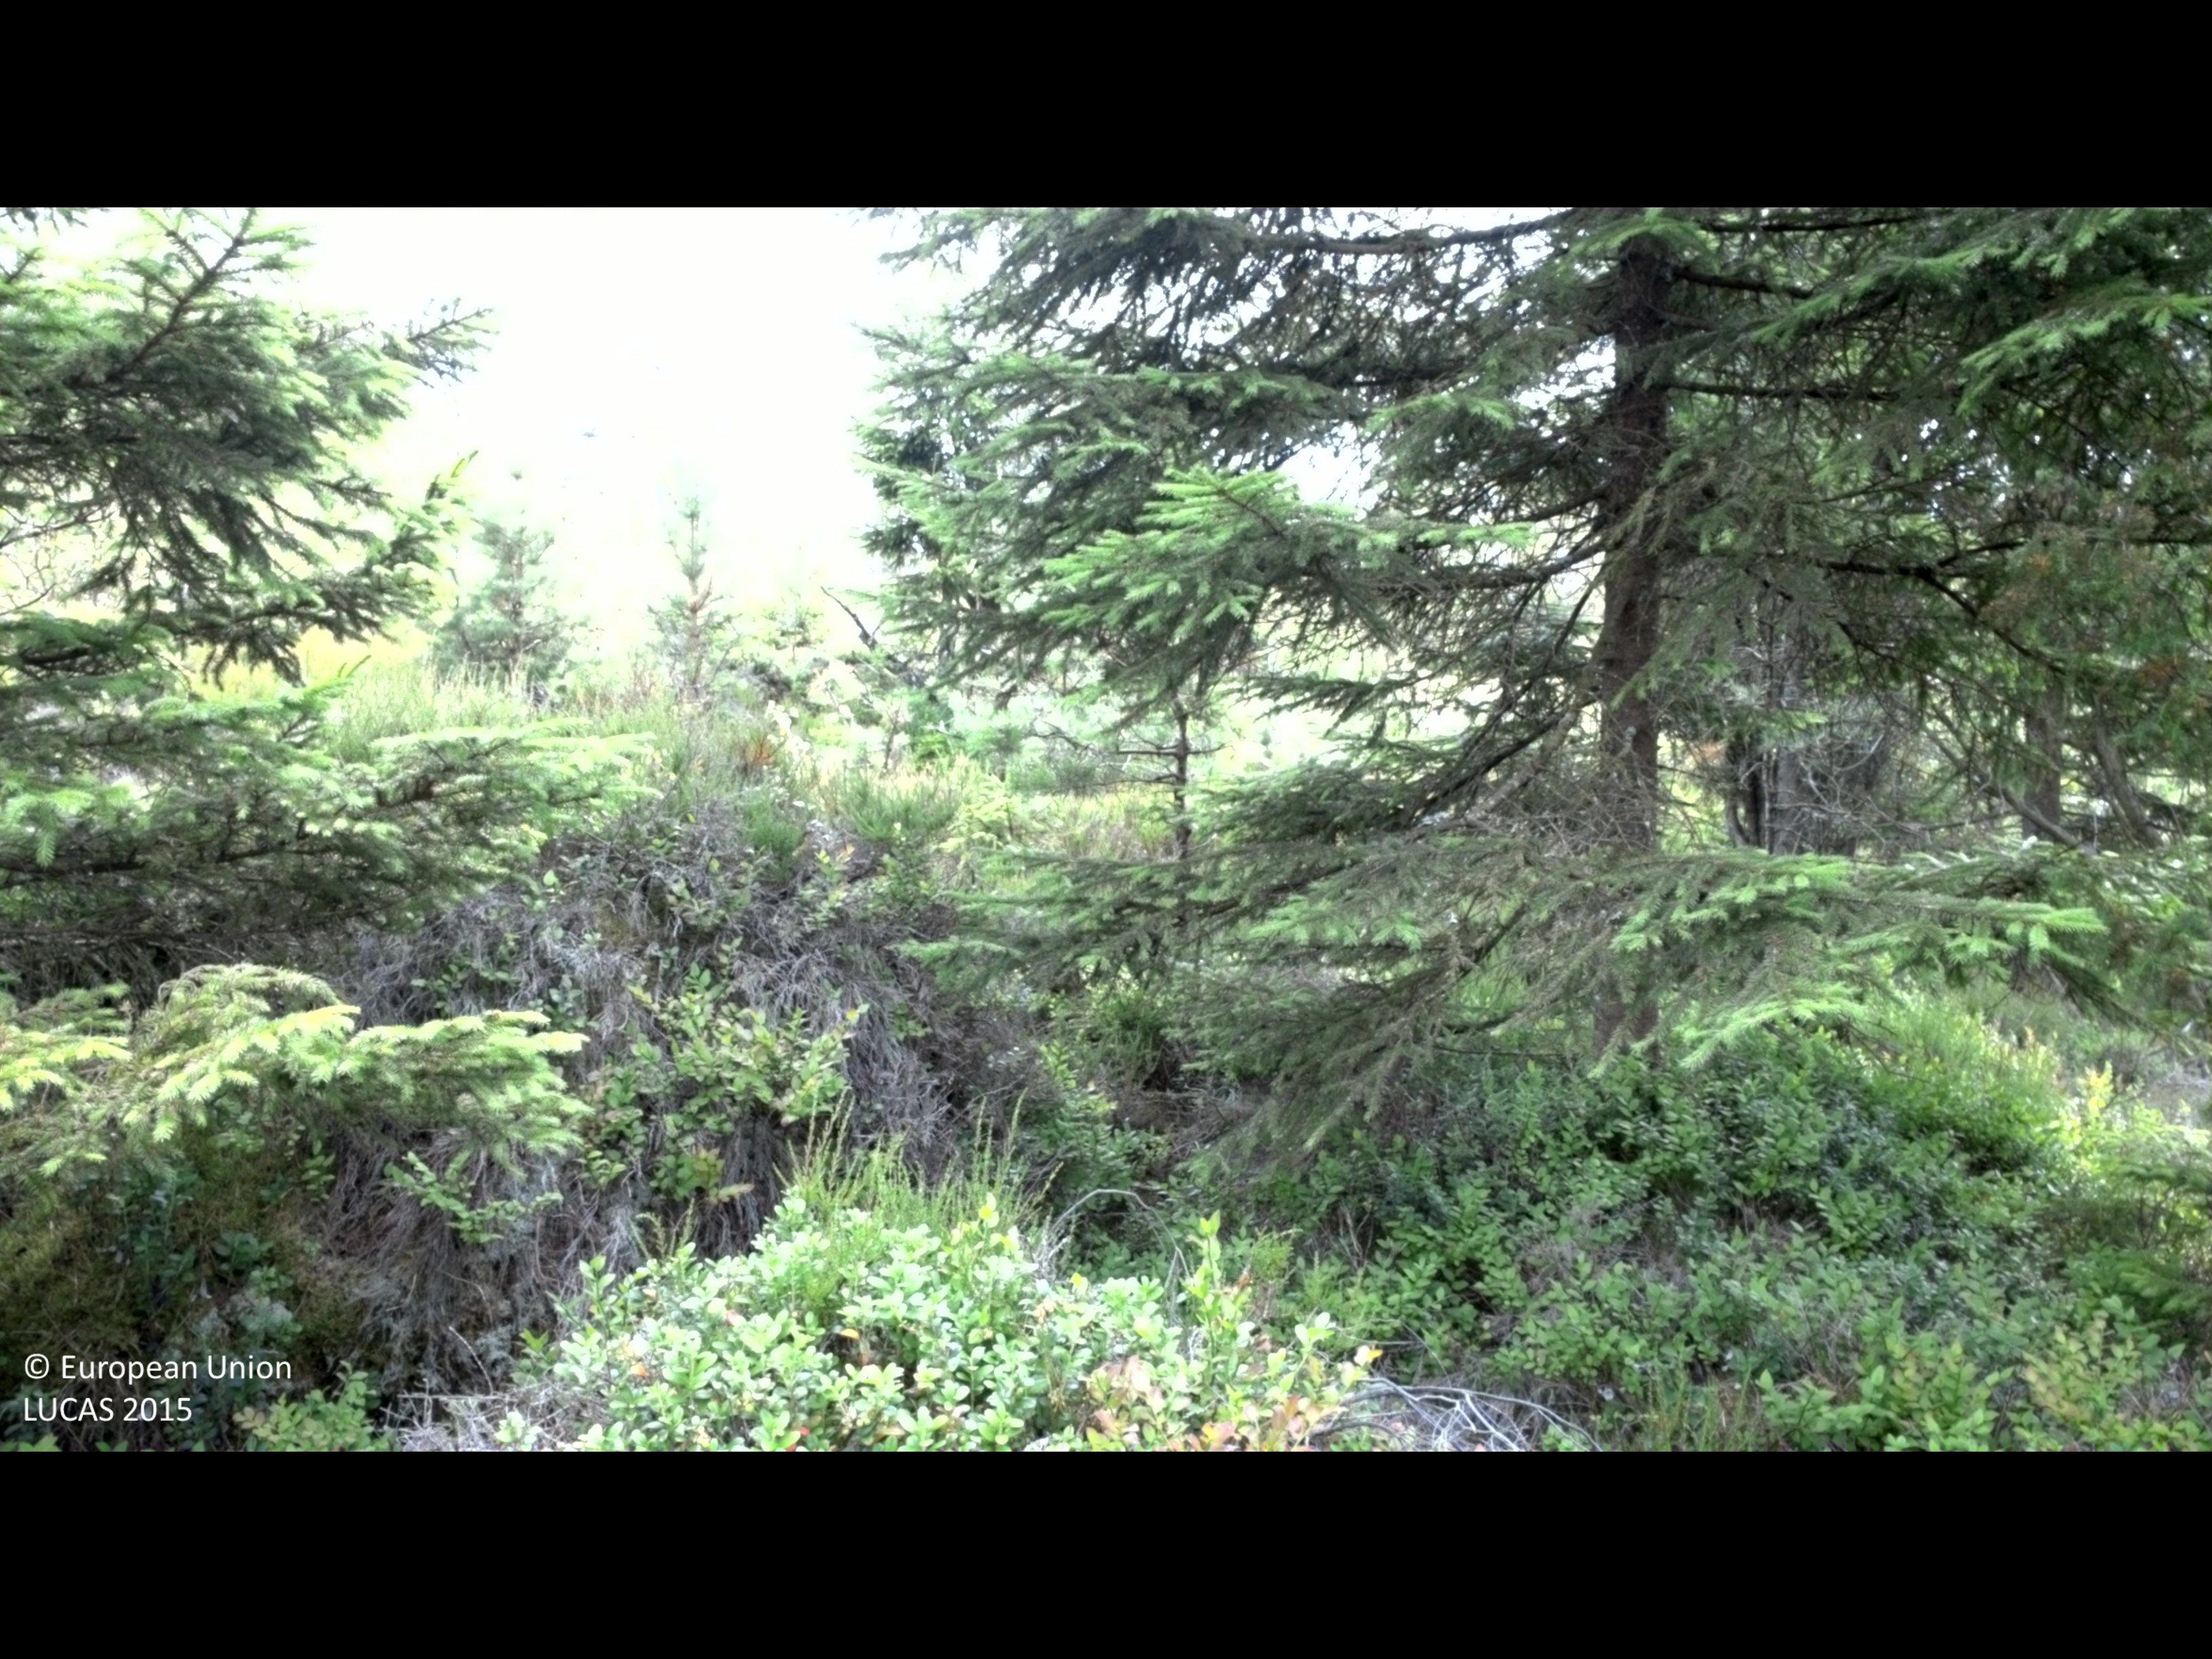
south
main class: Woodland
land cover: Pine dominated mixed woodland
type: boreal forest
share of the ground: 25 - 50 %
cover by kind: shrubs 35 %, coniferous forest trees 30 %, broadleaved forest trees 20 %, herbaceous plants 15 %
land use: Forestry
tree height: > 5 m
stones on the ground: 25 - 50 %
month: July
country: SE
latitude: 56.5289
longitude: 13.7525
